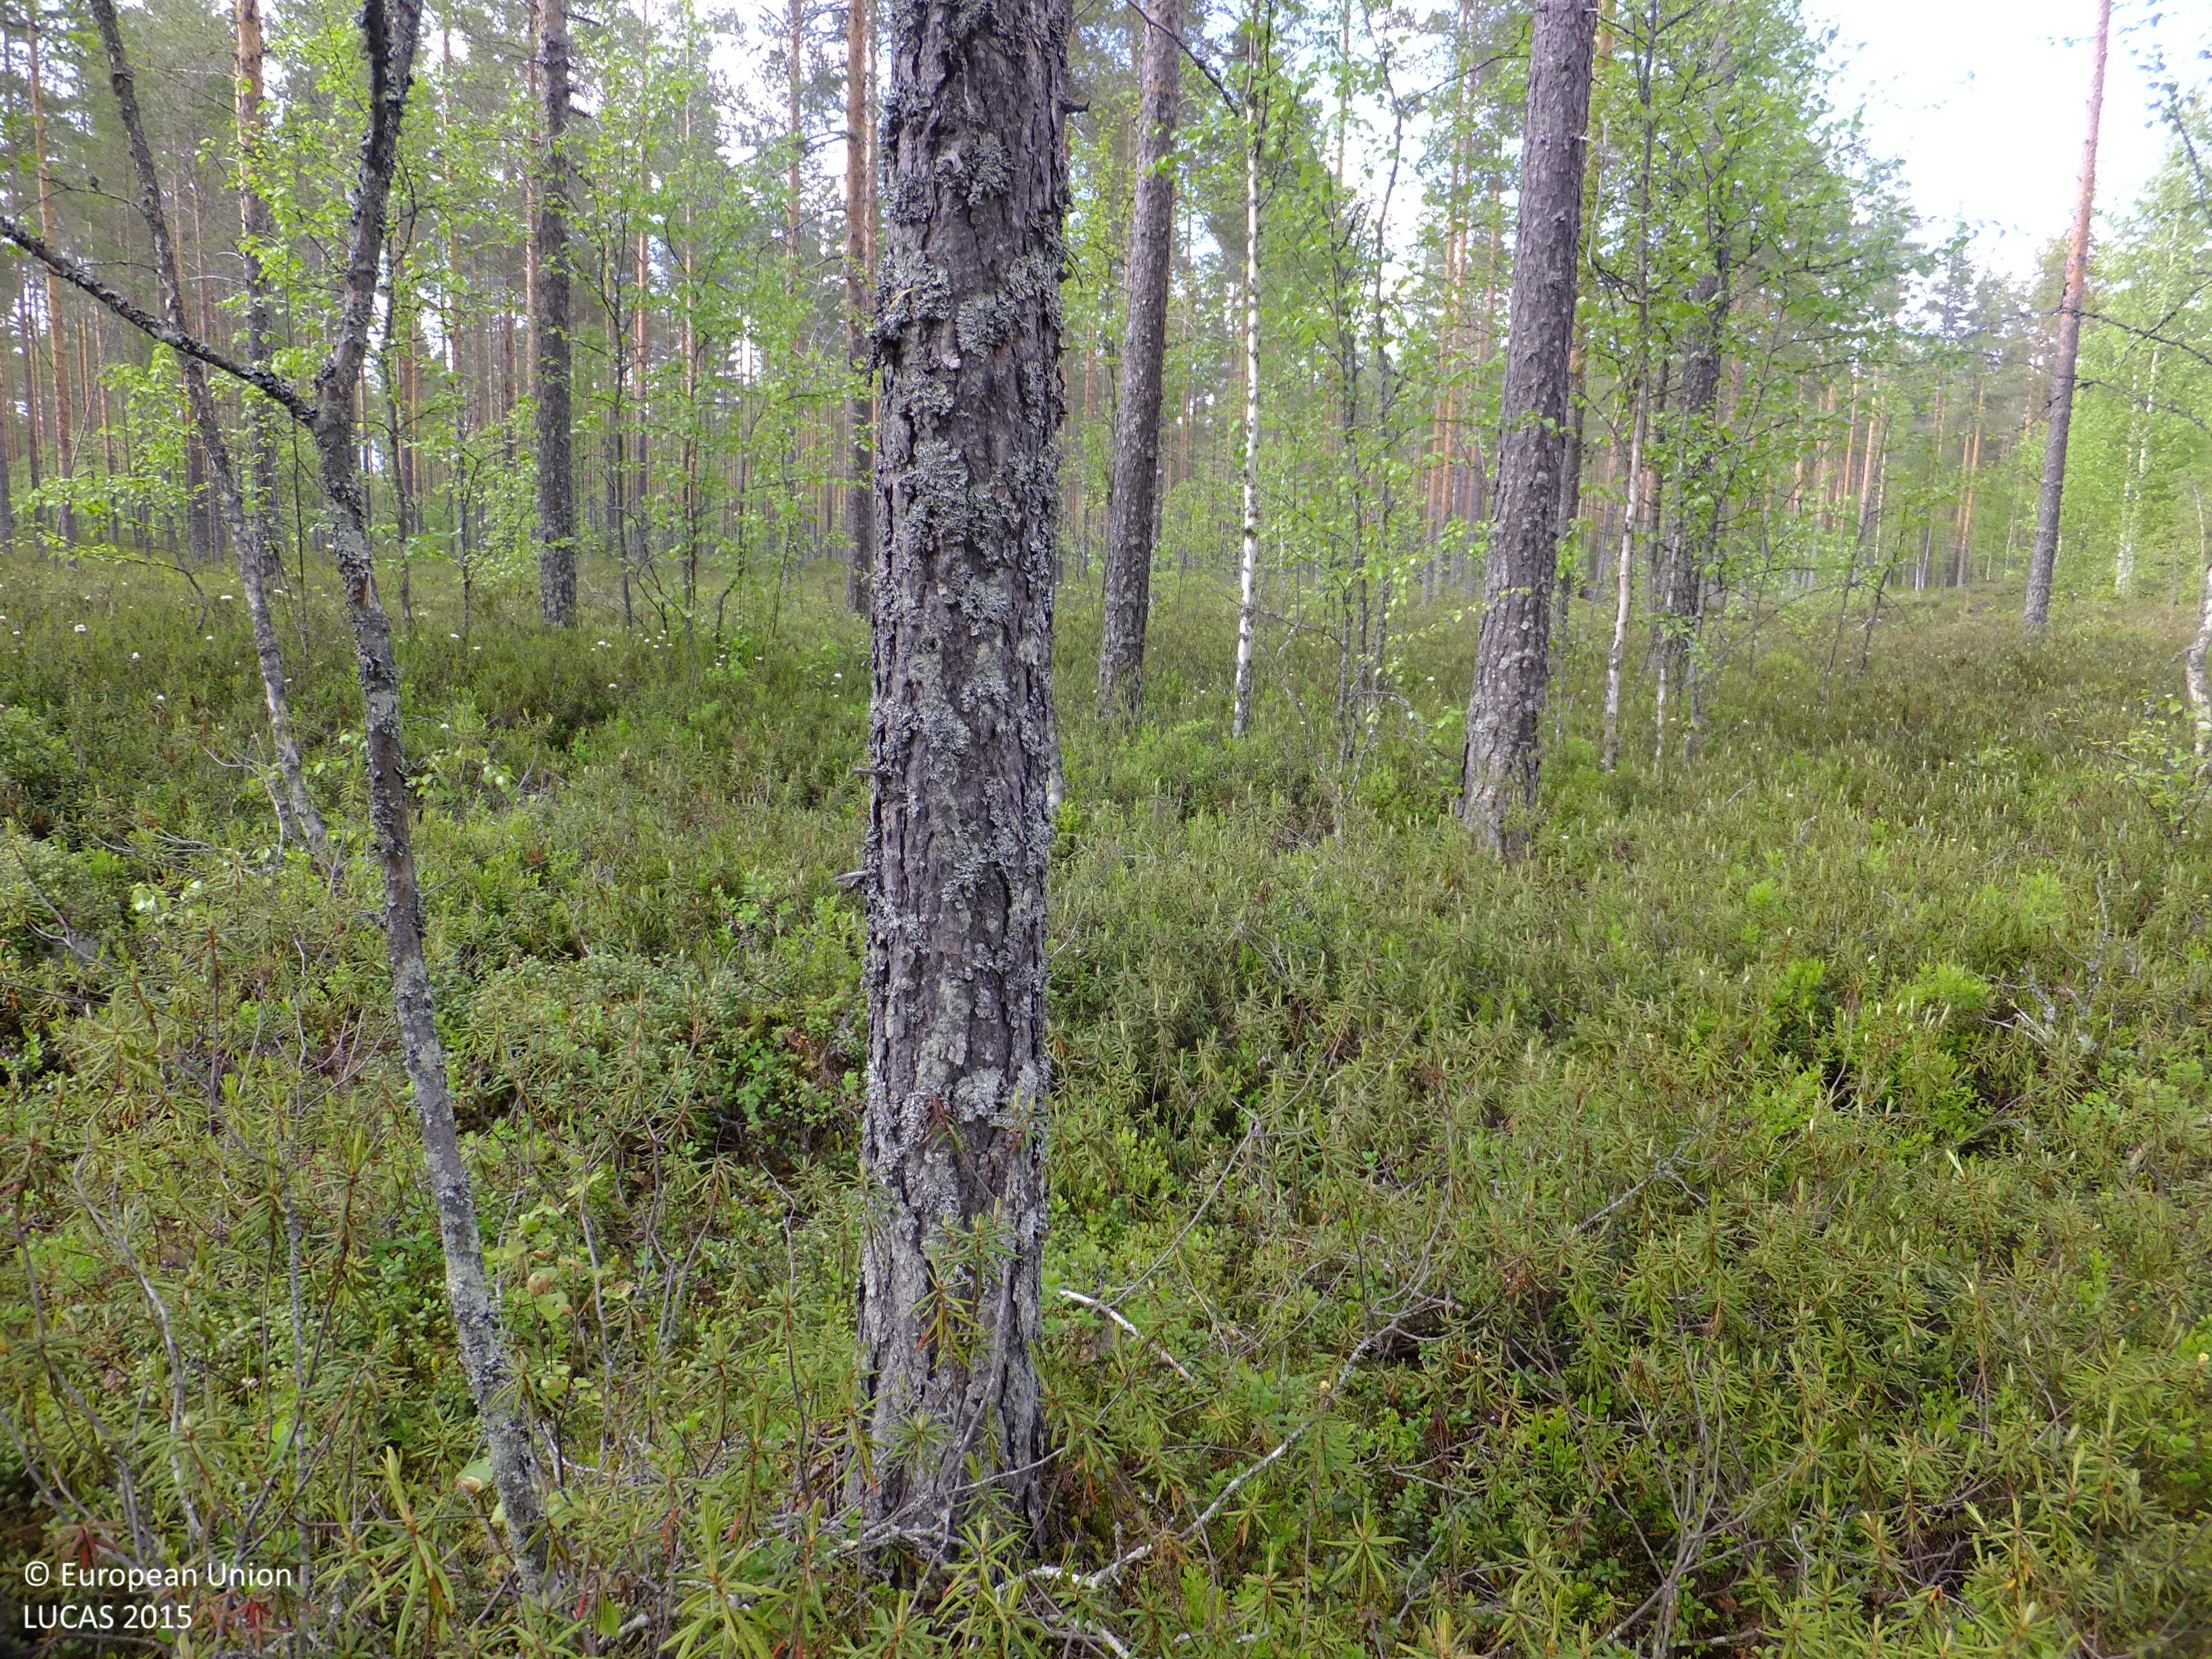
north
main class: Woodland
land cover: Pine dominated coniferous woodland
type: boreal forest
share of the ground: > 75 %
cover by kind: coniferous forest trees 70 %, herbaceous plants 15 %, shrubs 10 %, broadleaved forest trees 5 %
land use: Forestry
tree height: > 5 m
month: June
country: FI
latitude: 63.4852
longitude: 24.7210
